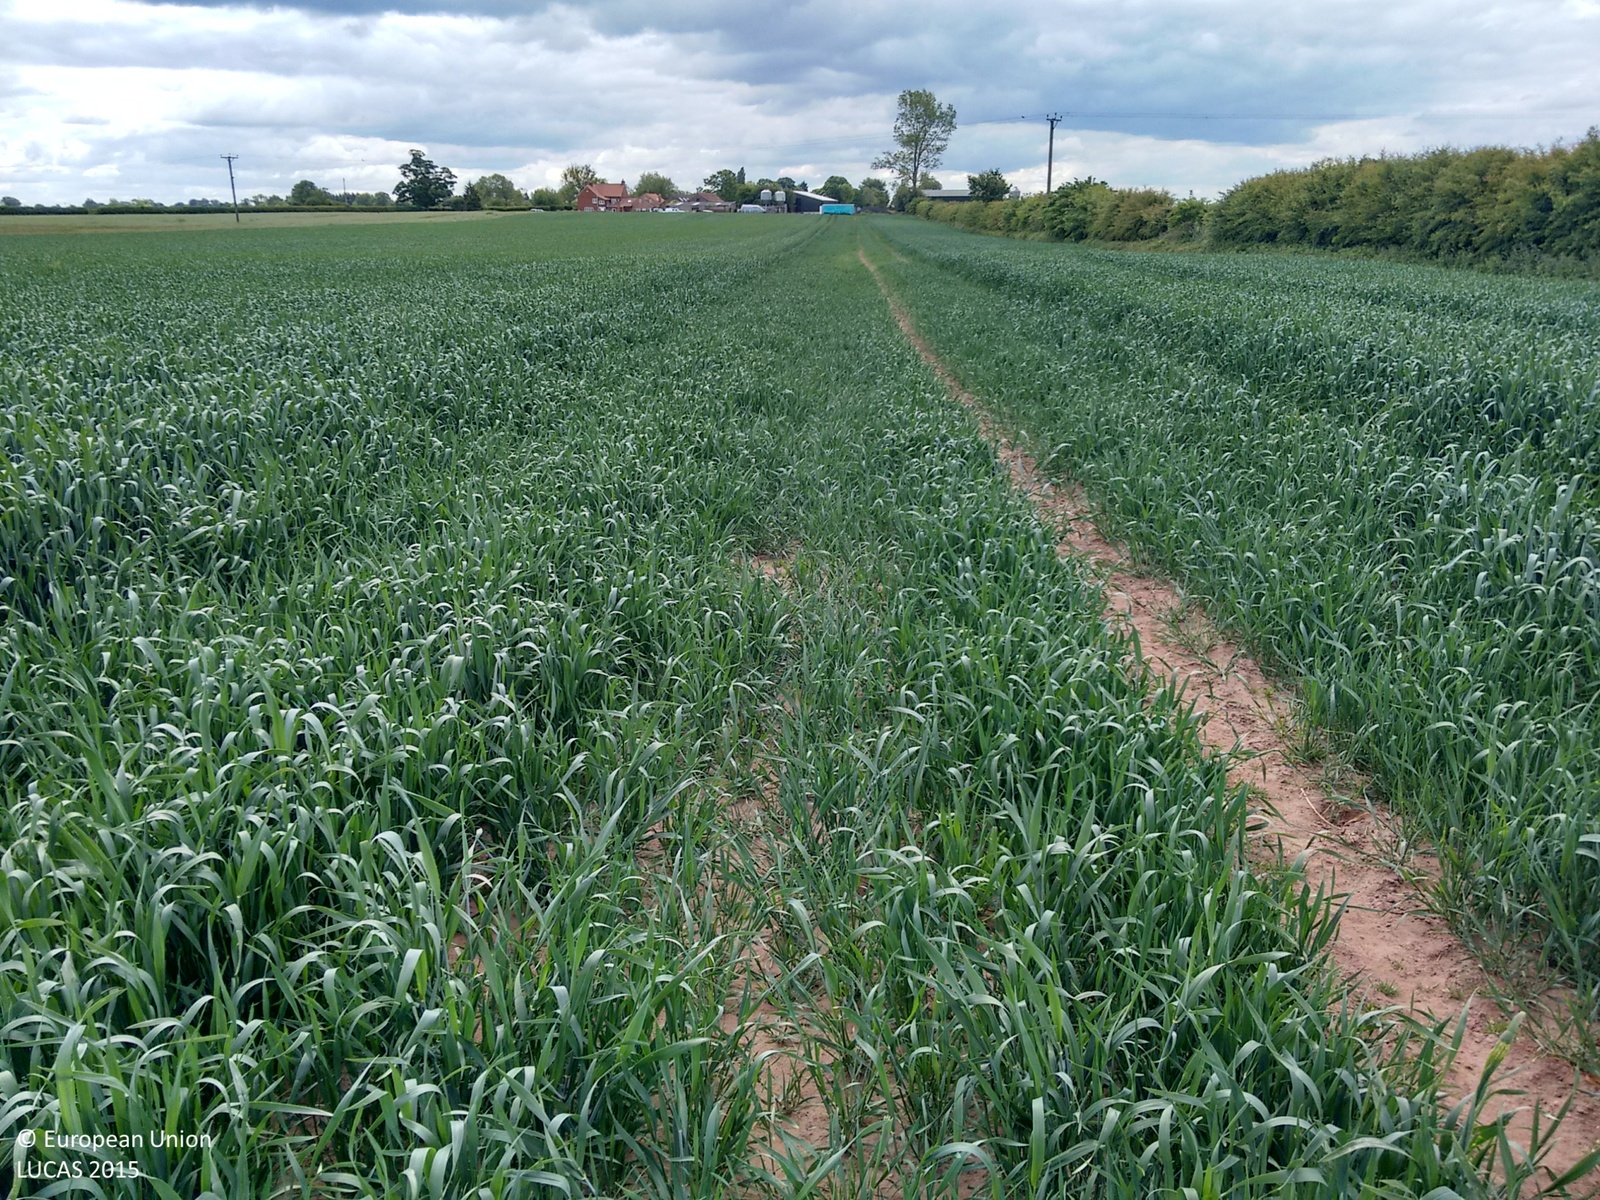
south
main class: Cropland
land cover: Common wheat
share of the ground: > 75 %
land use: Agriculture (excluding fallow land and kitchen gardens)
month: June
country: GB
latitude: 54.2405
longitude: -1.4179
